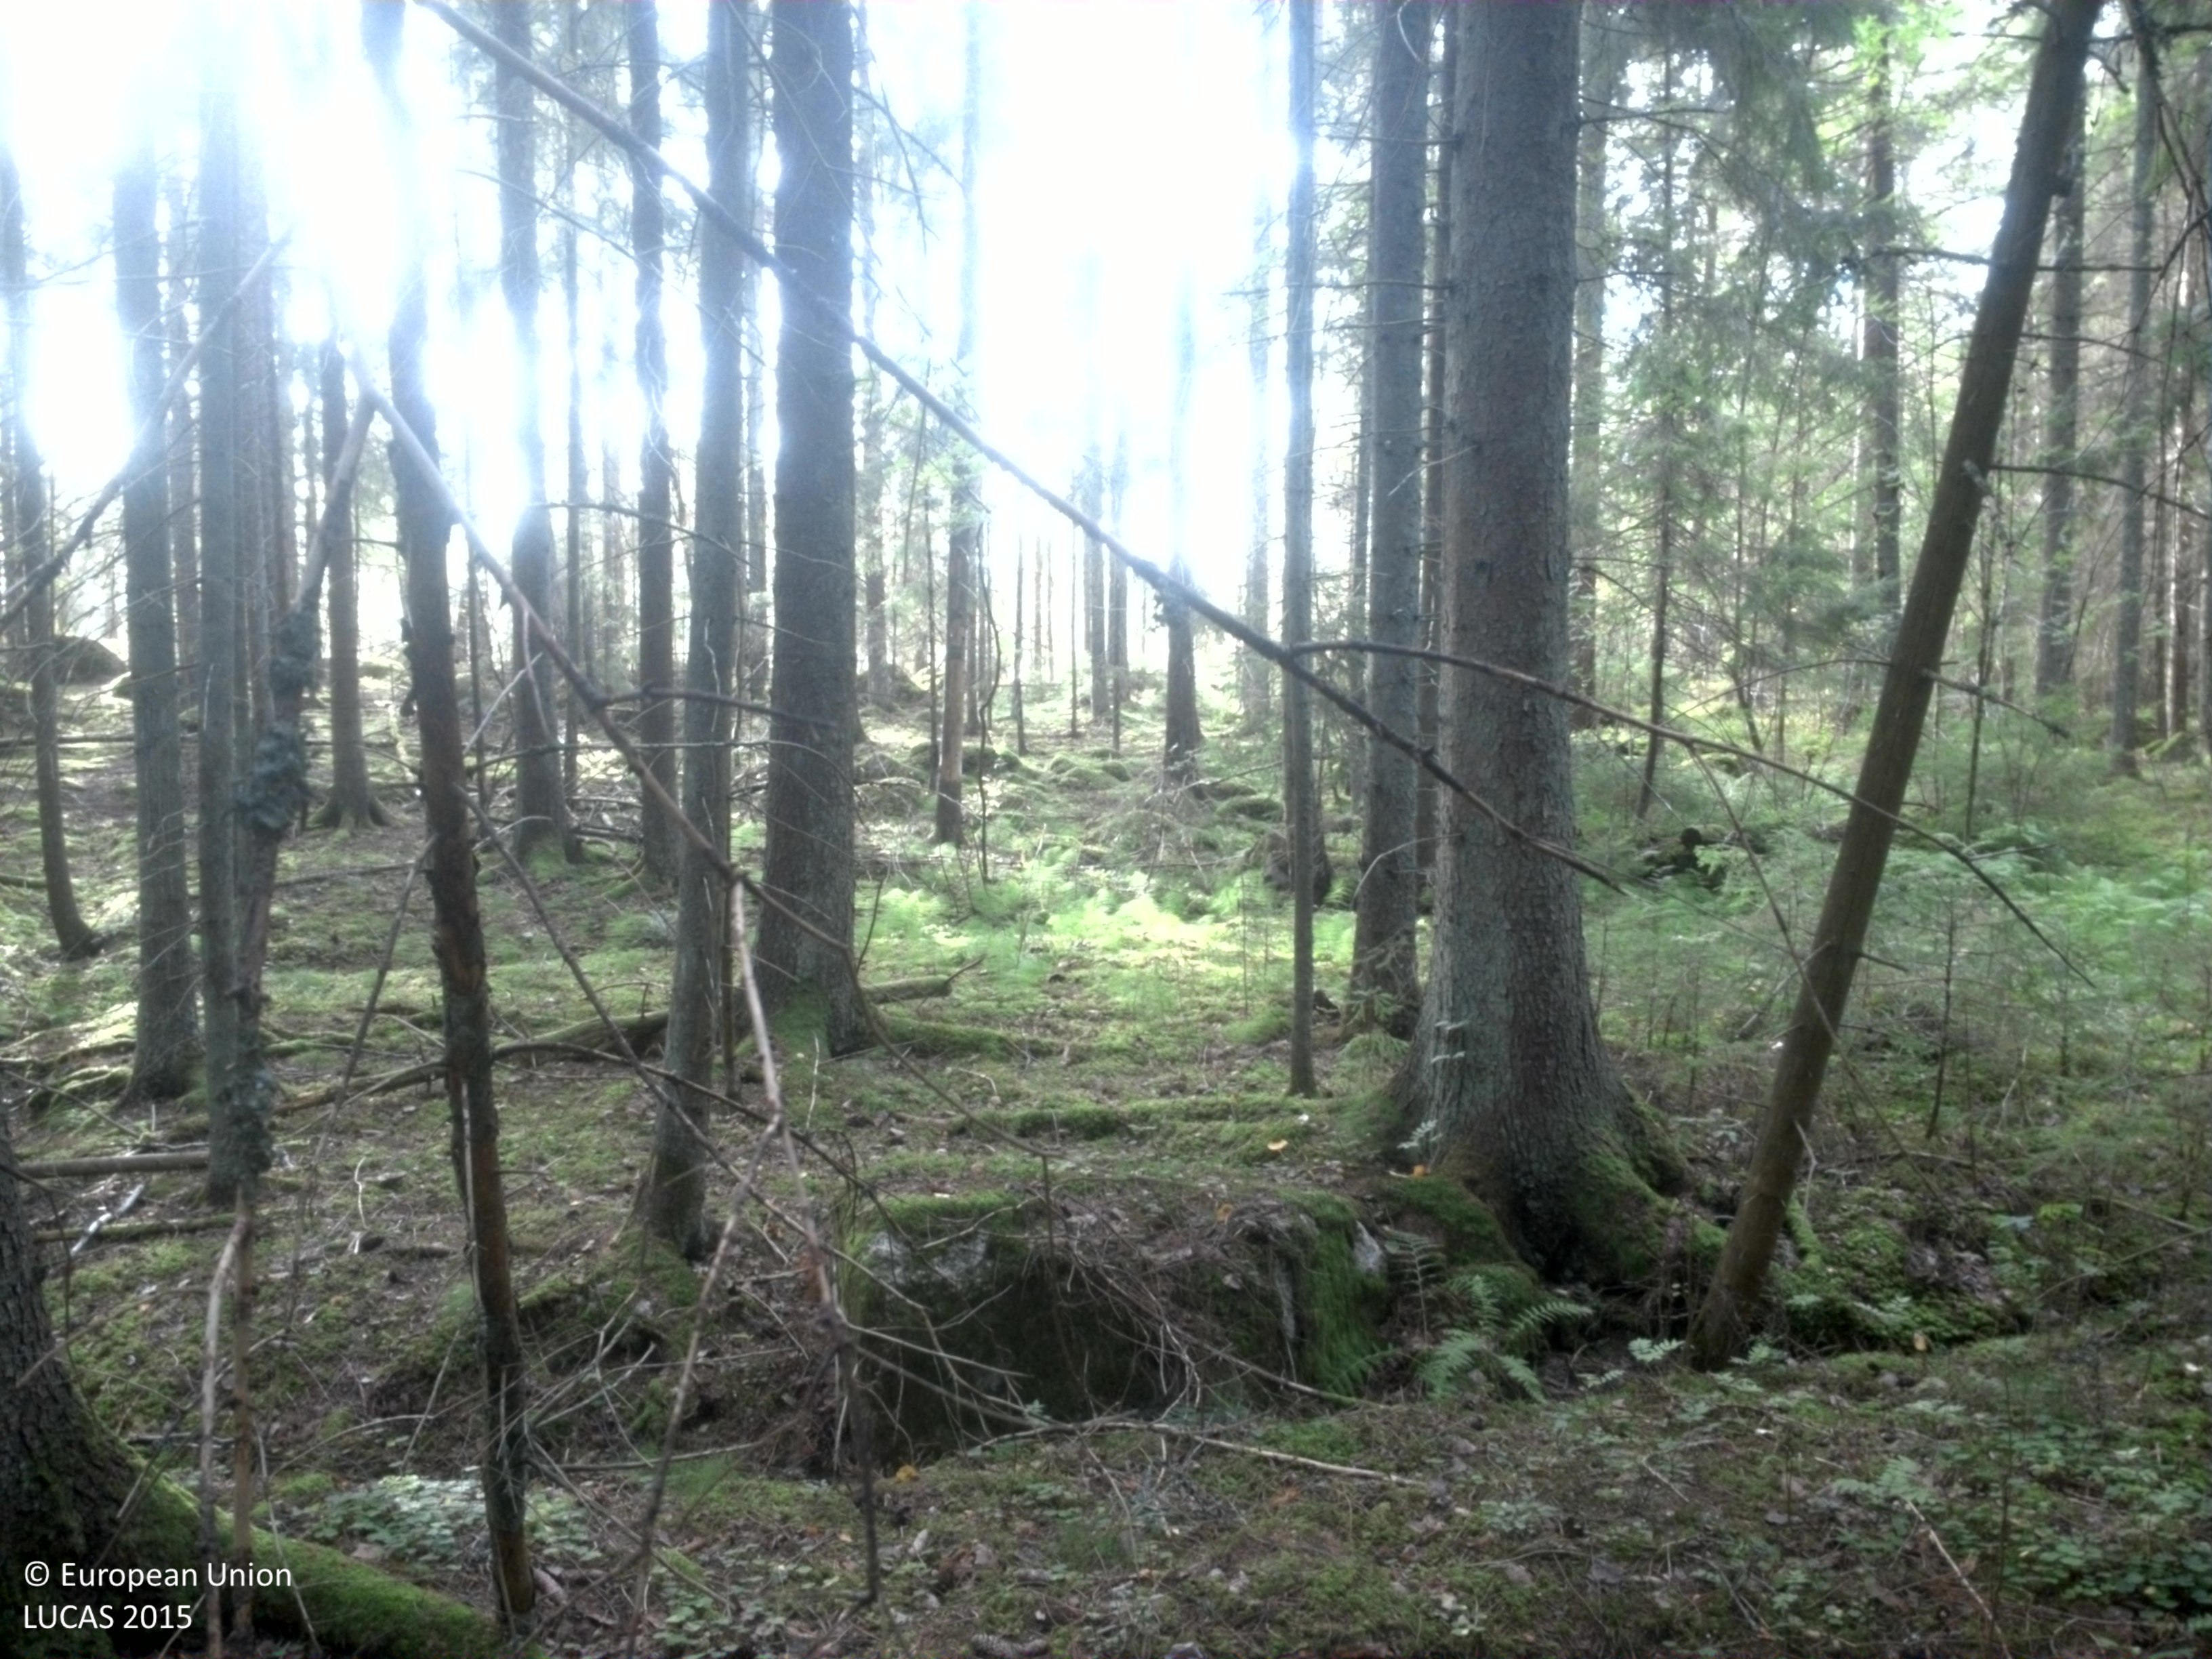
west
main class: Woodland
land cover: Spruce dominated coniferous woodland
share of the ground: > 75 %
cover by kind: coniferous forest trees 70 %, lichens and mosses 15 %, broadleaved forest trees 10 %, shrubs 5 %
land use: Forestry
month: September
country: SE
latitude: 59.4910
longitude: 15.6246
